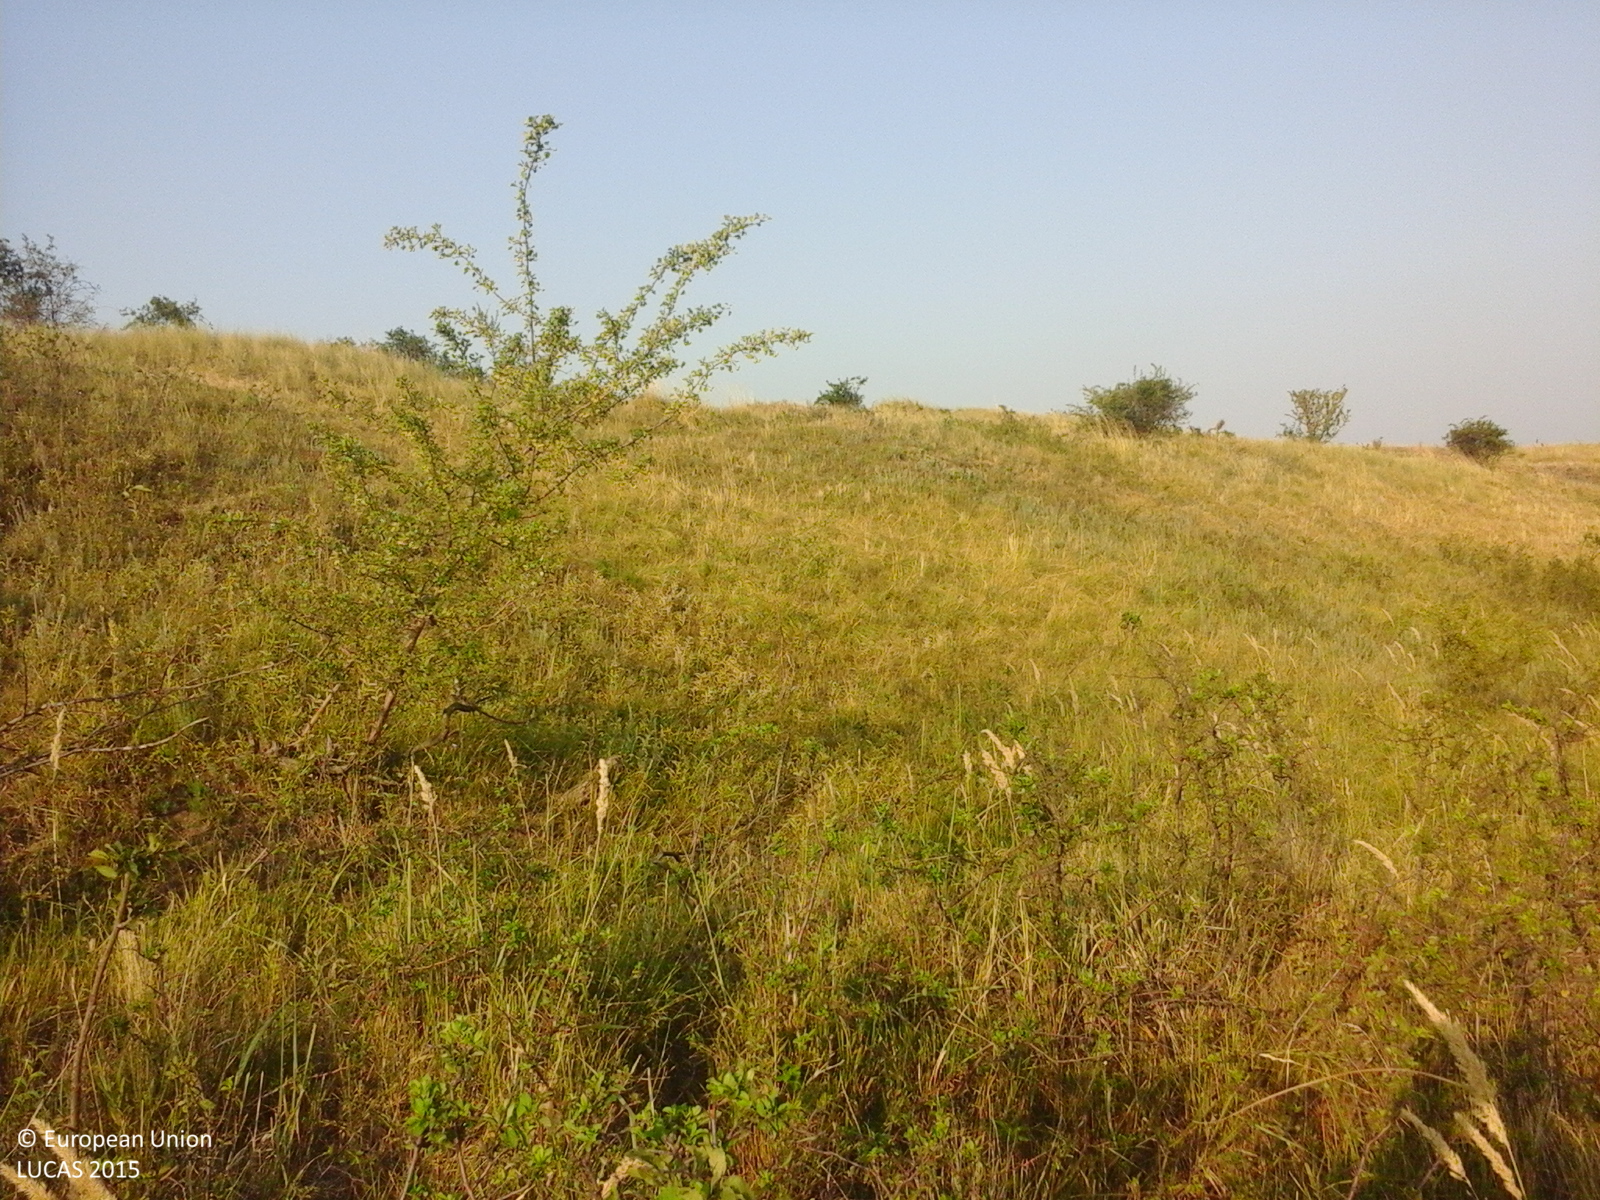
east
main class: Grassland
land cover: Grassland with sparse tree/shrub cover
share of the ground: > 75 %
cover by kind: herbaceous plants 95 %, broadleaved forest trees 5 %
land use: Agriculture (excluding fallow land and kitchen gardens)
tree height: < 5 m
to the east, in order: Grassland with sparse tree/shrub cover; Tracks; Maize
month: July
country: RO
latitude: 46.1313
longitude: 27.1432
